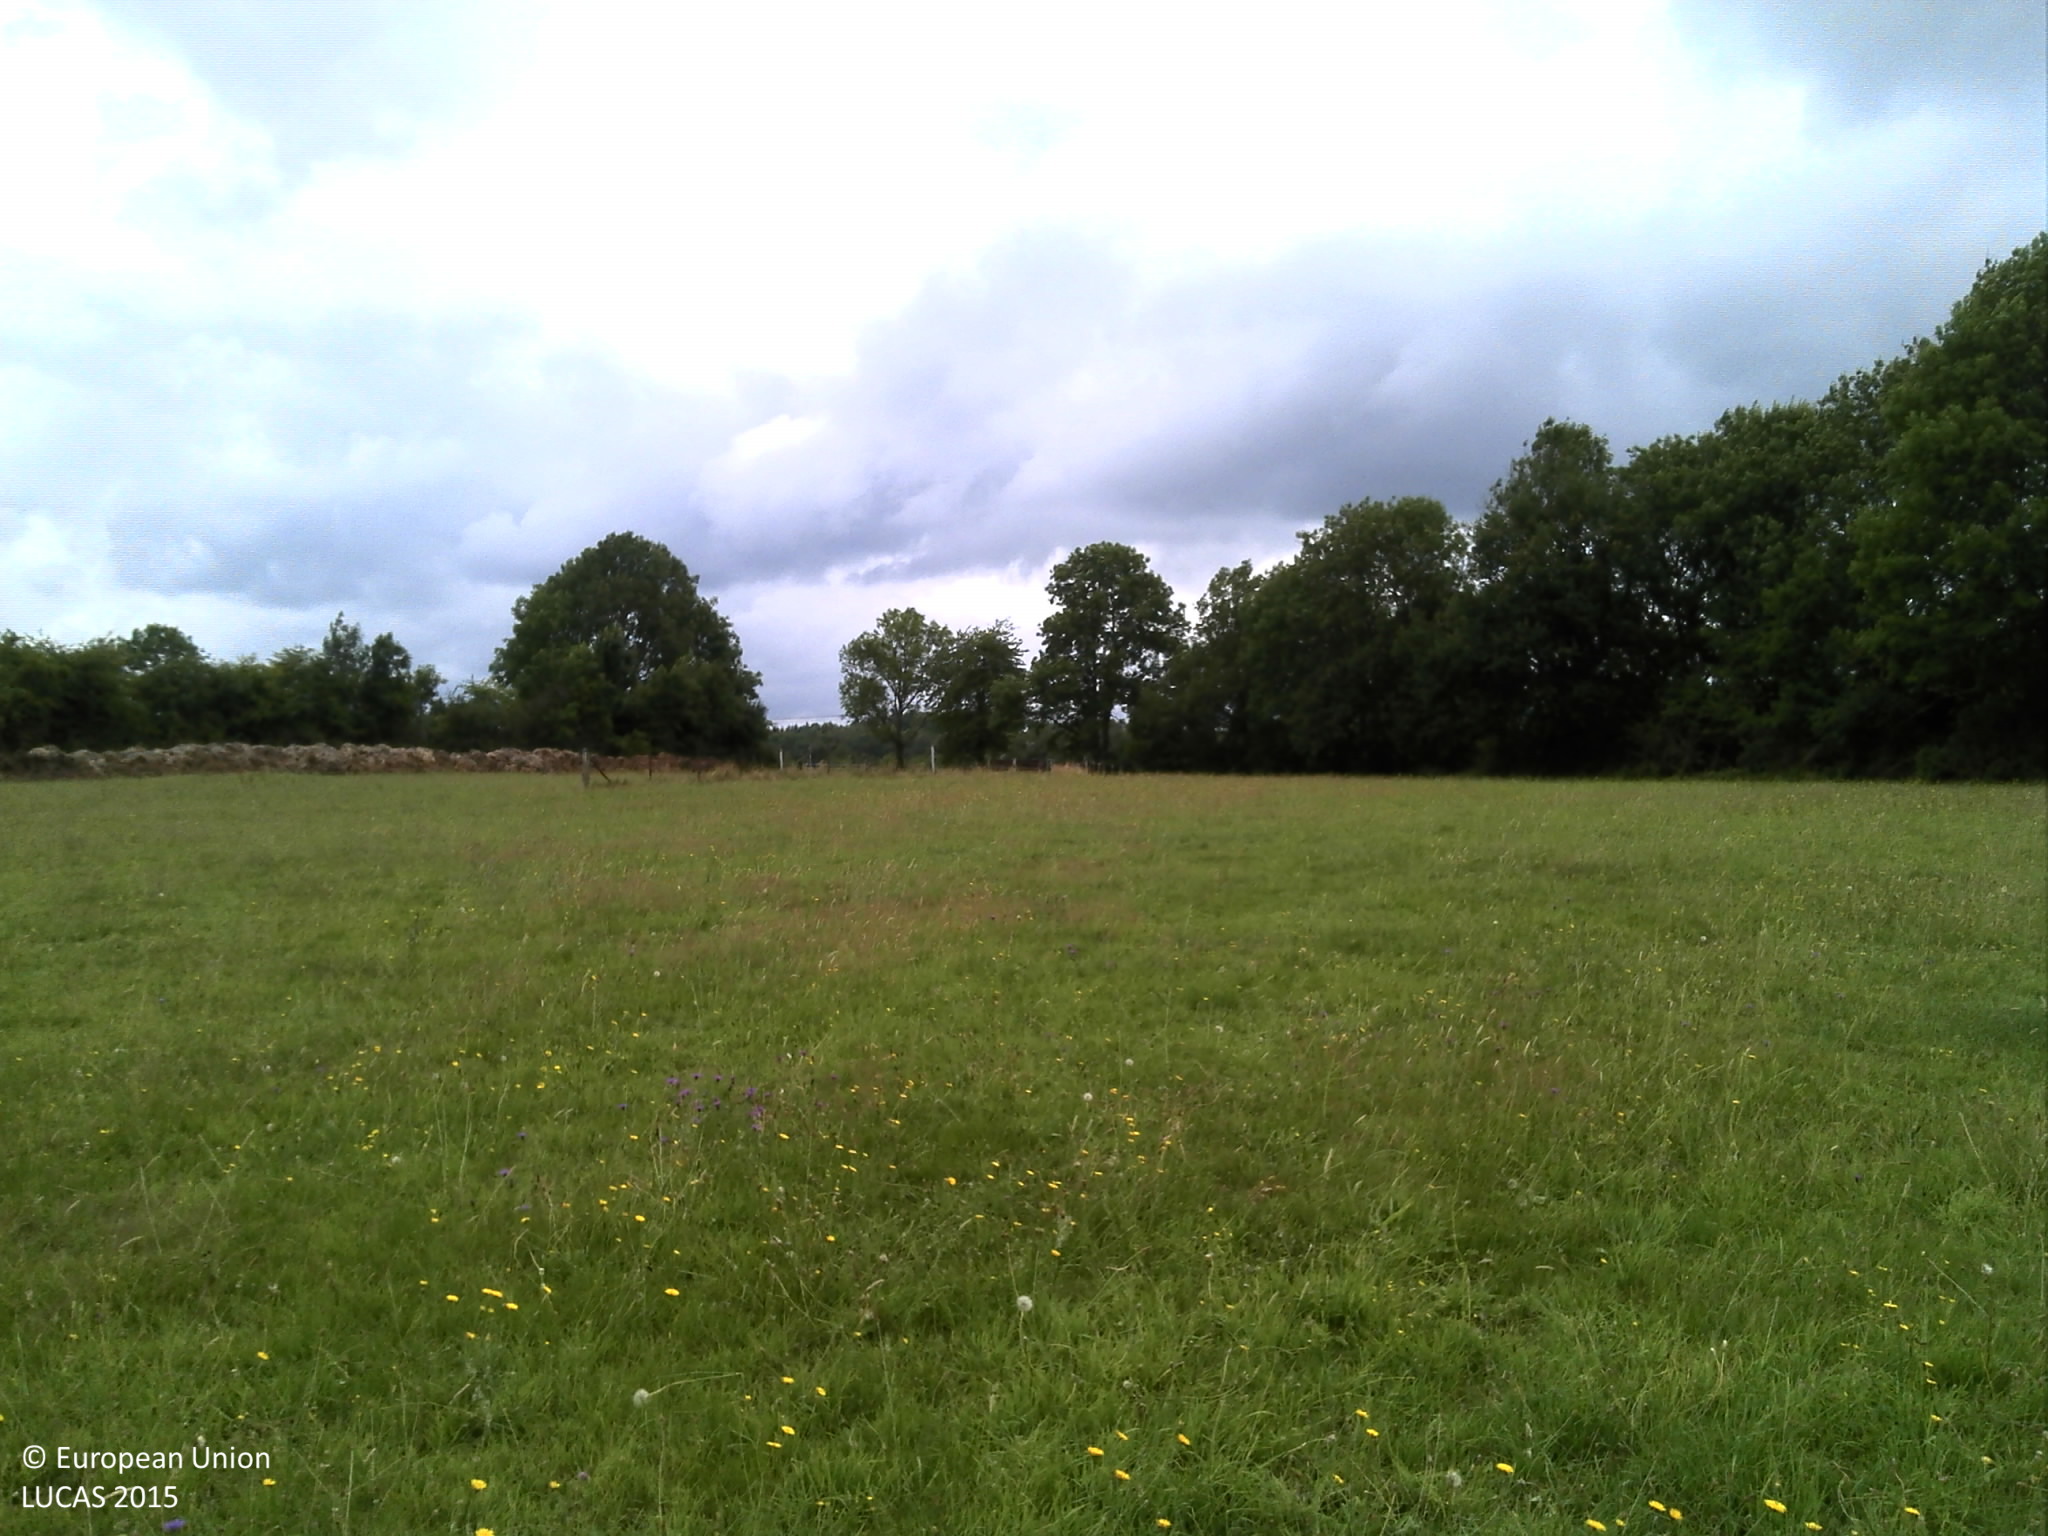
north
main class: Grassland
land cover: Grassland without tree/shrub cover
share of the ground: > 75 %
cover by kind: herbaceous plants 100 %
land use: Agriculture (excluding fallow land and kitchen gardens)
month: July
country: FR
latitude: 49.8408
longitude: 4.6151
